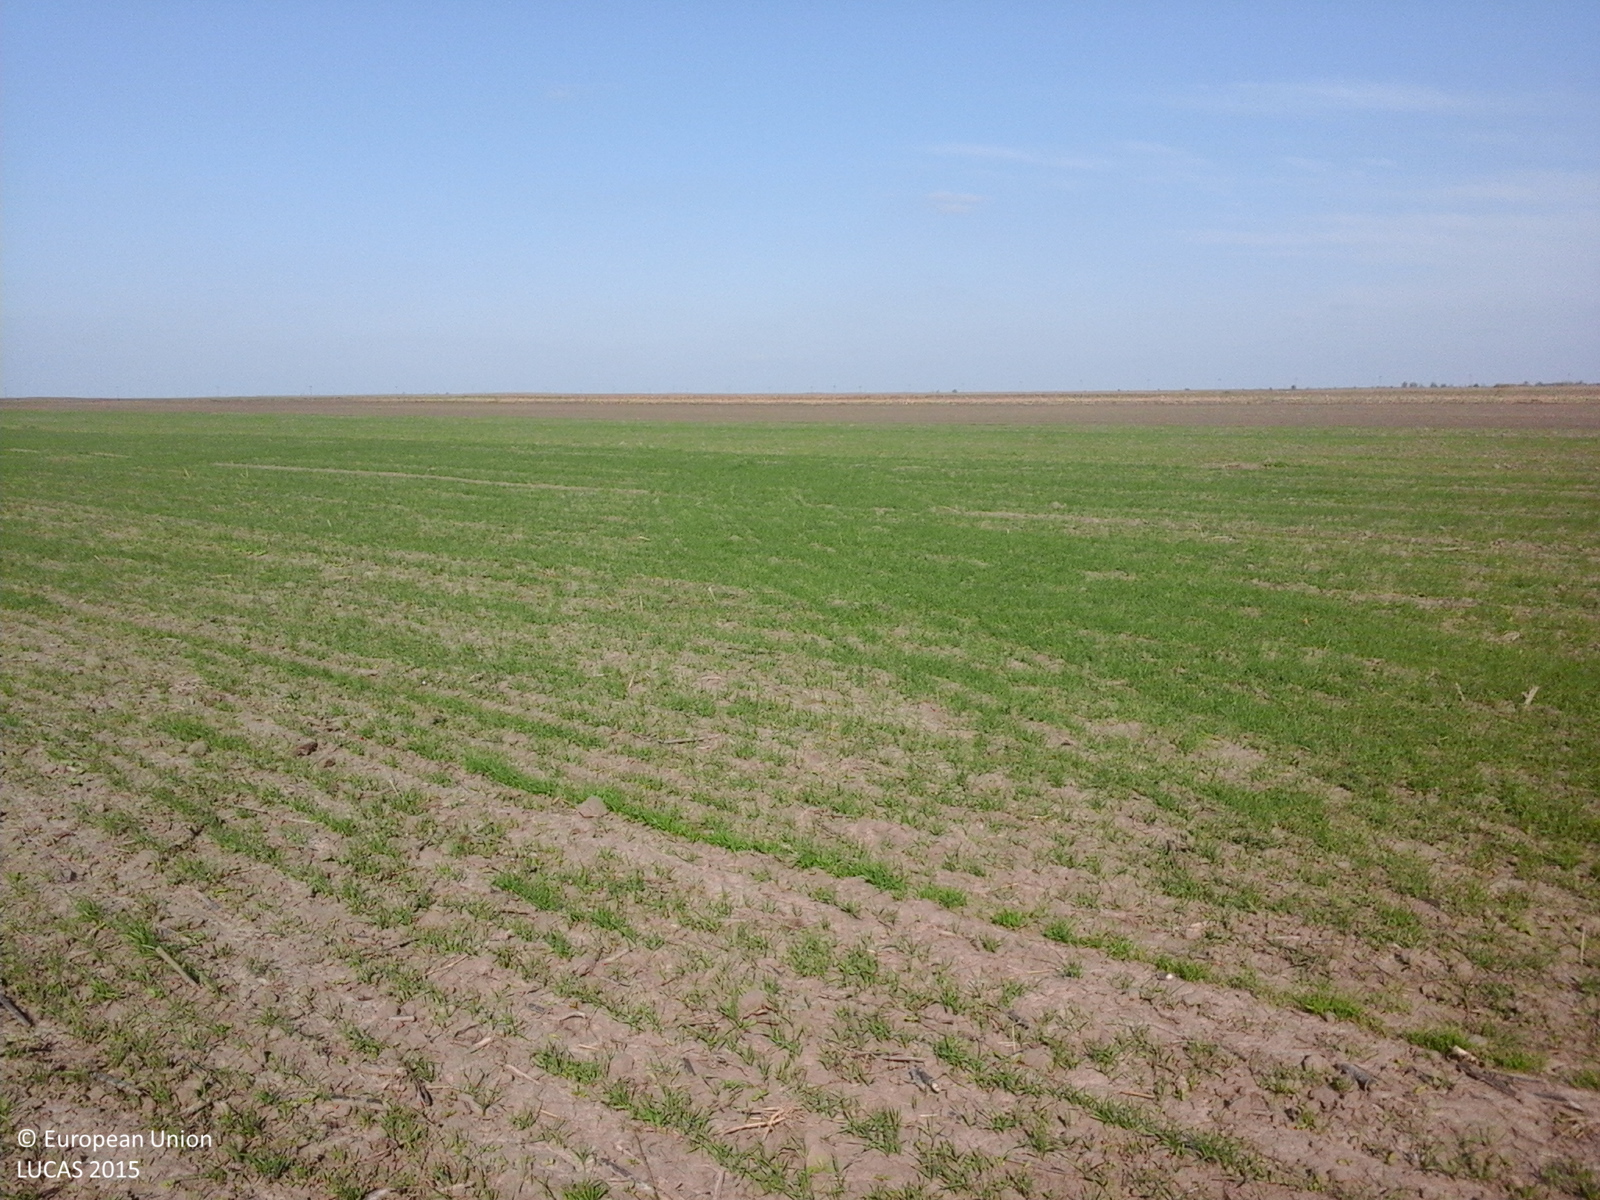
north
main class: Cropland
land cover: Common wheat
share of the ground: 10 - 25 %
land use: Agriculture (excluding fallow land and kitchen gardens)
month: October
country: RO
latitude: 45.4627
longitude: 27.4029
